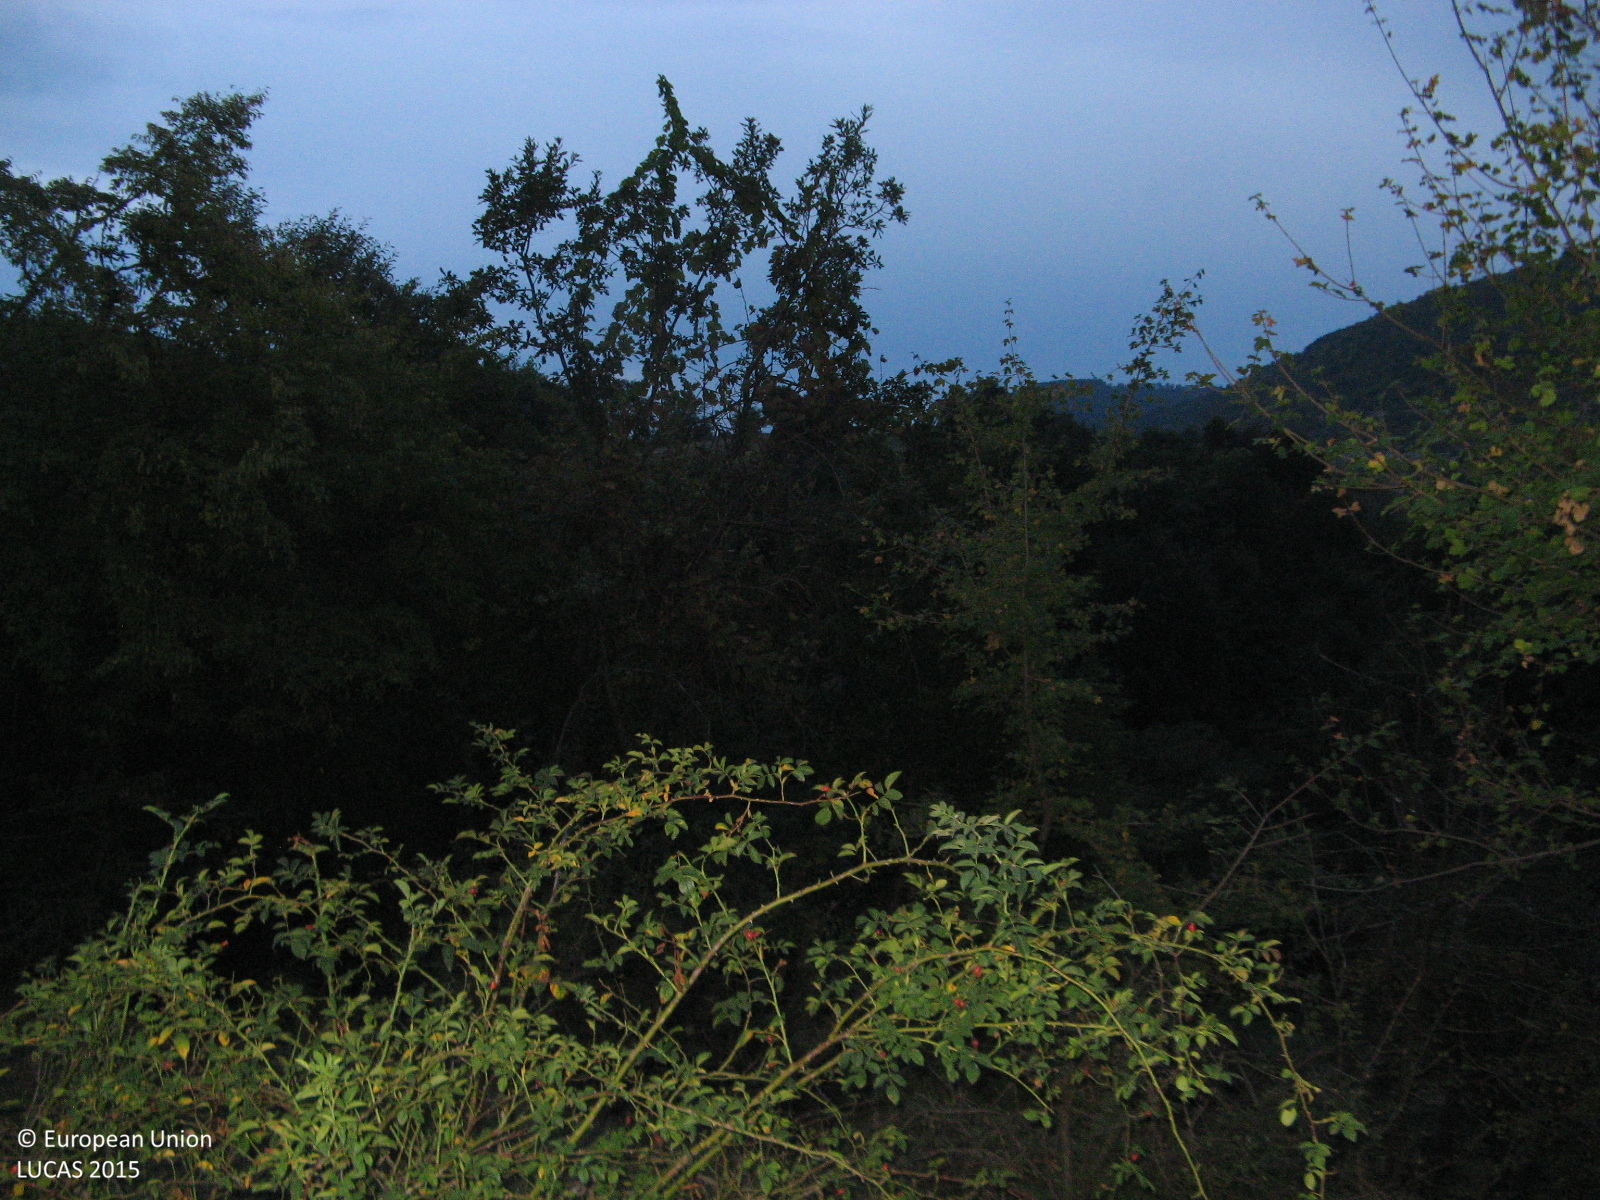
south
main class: Grassland
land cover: Grassland with sparse tree/shrub cover
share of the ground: > 75 %
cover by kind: herbaceous plants 85 %, shrubs 10 %, broadleaved forest trees 5 %
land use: Agriculture (excluding fallow land and kitchen gardens)
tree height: > 5 m
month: October
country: BG
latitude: 41.6993
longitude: 25.3296
